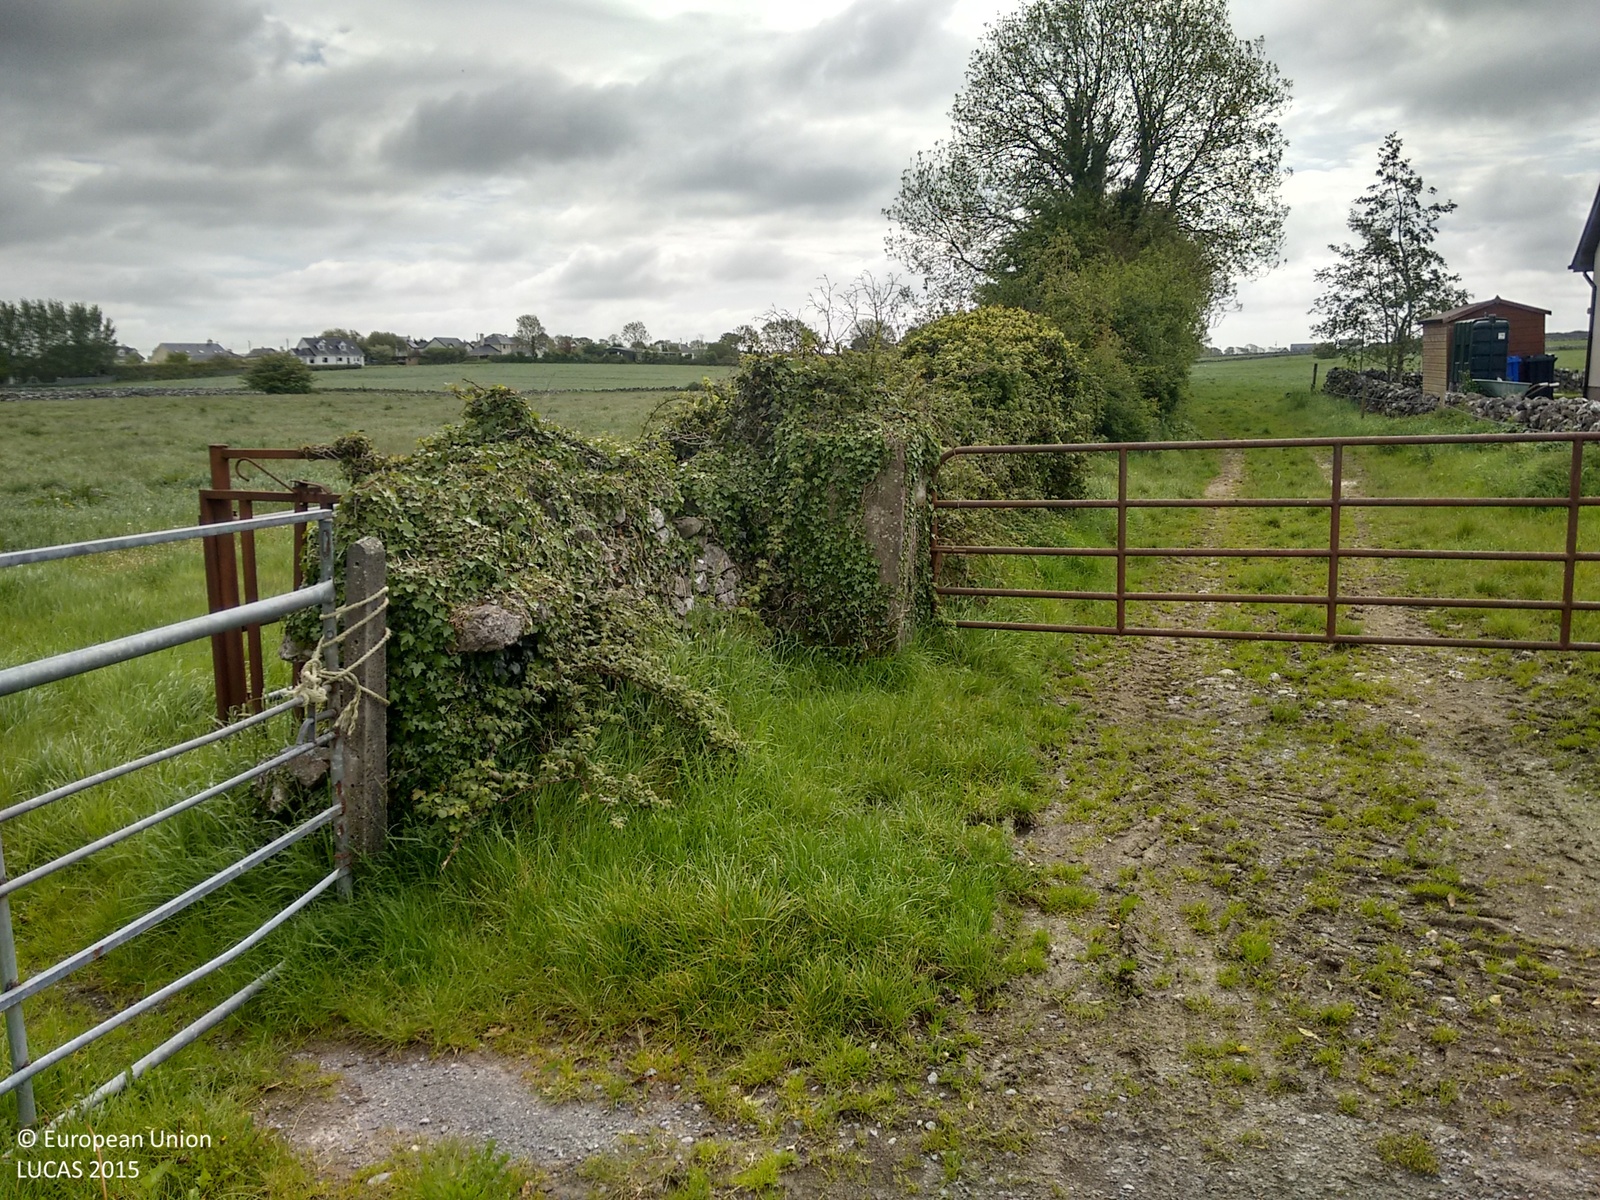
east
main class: Grassland
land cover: Grassland without tree/shrub cover
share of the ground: > 75 %
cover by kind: herbaceous plants 100 %
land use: Agriculture (excluding fallow land and kitchen gardens)
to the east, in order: Grassland without tree/shrub cover; Paved roads, cycling and walking lanes; Artificial constructions; Paved roads, cycling and walking lanes; Dry stone walls; Grassland without tree/shrub cover
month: May
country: IE
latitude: 53.3307
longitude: -8.9345
